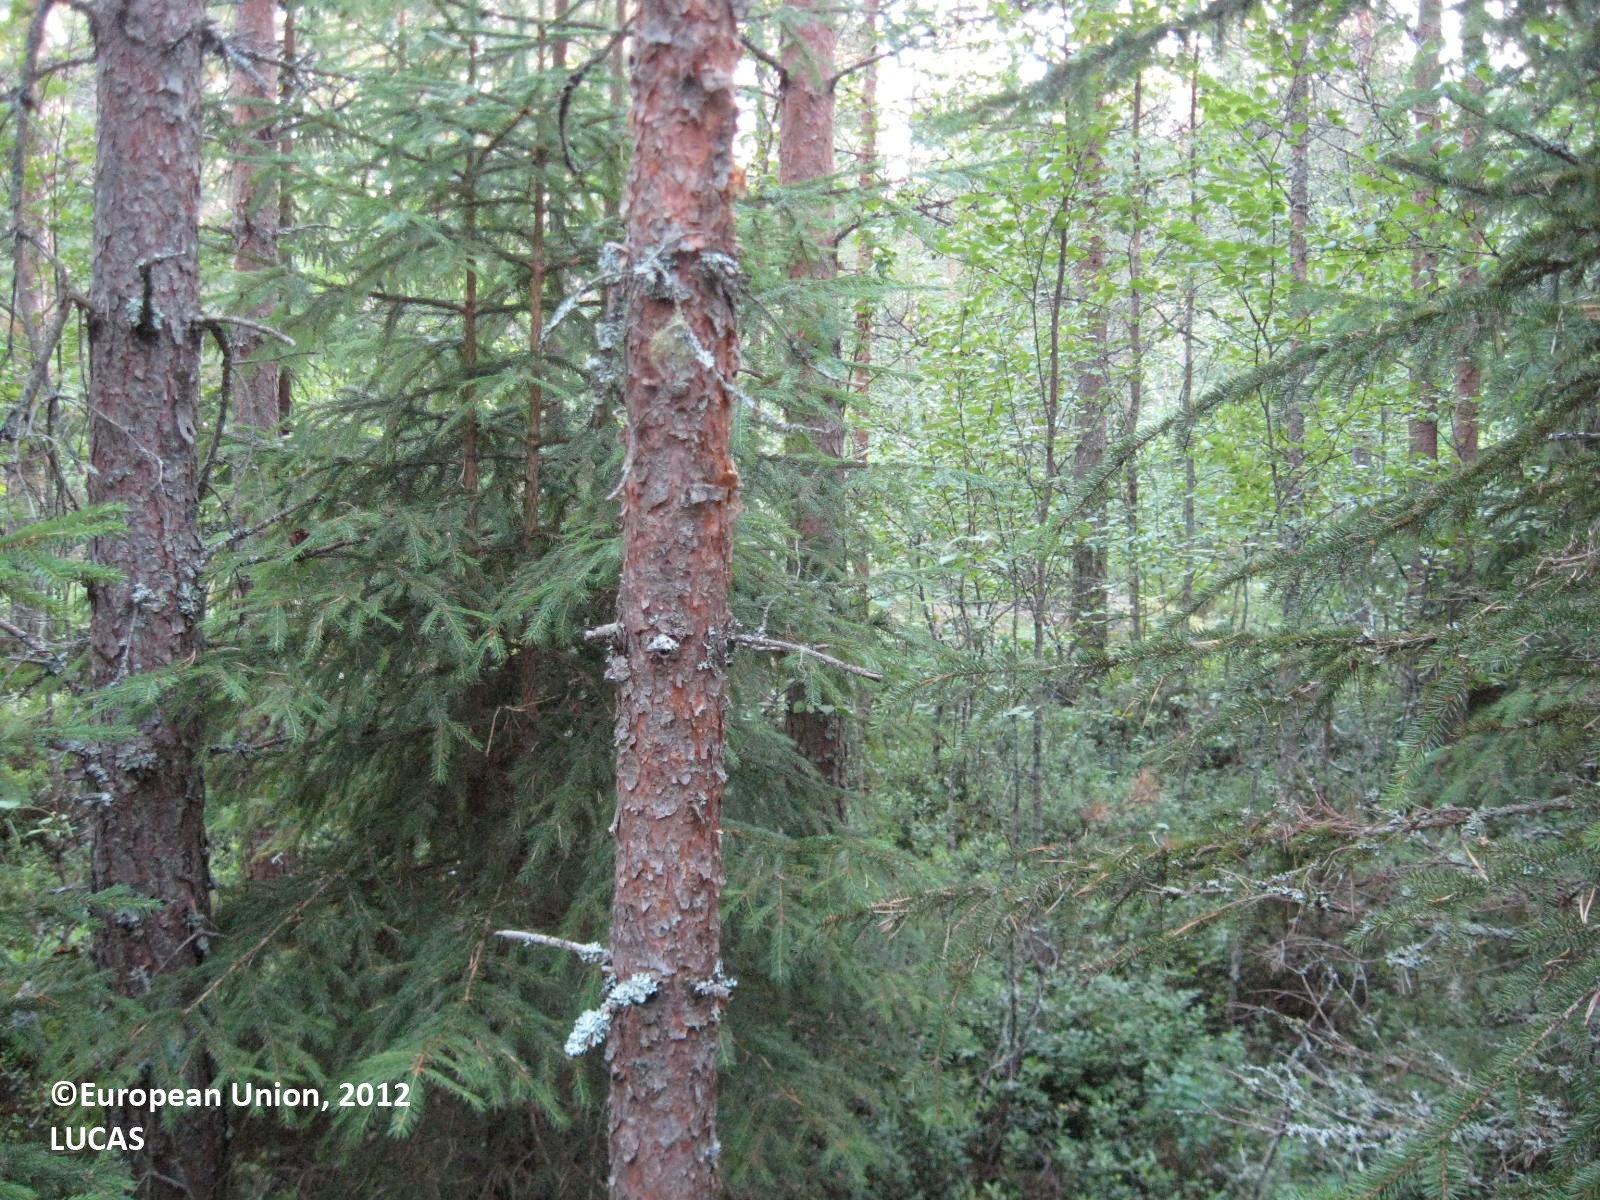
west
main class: Woodland
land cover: Pine dominated mixed woodland
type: boreal forest
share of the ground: > 75 %
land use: Forestry
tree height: > 5 m
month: July
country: FI
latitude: 62.4179
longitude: 21.6027
